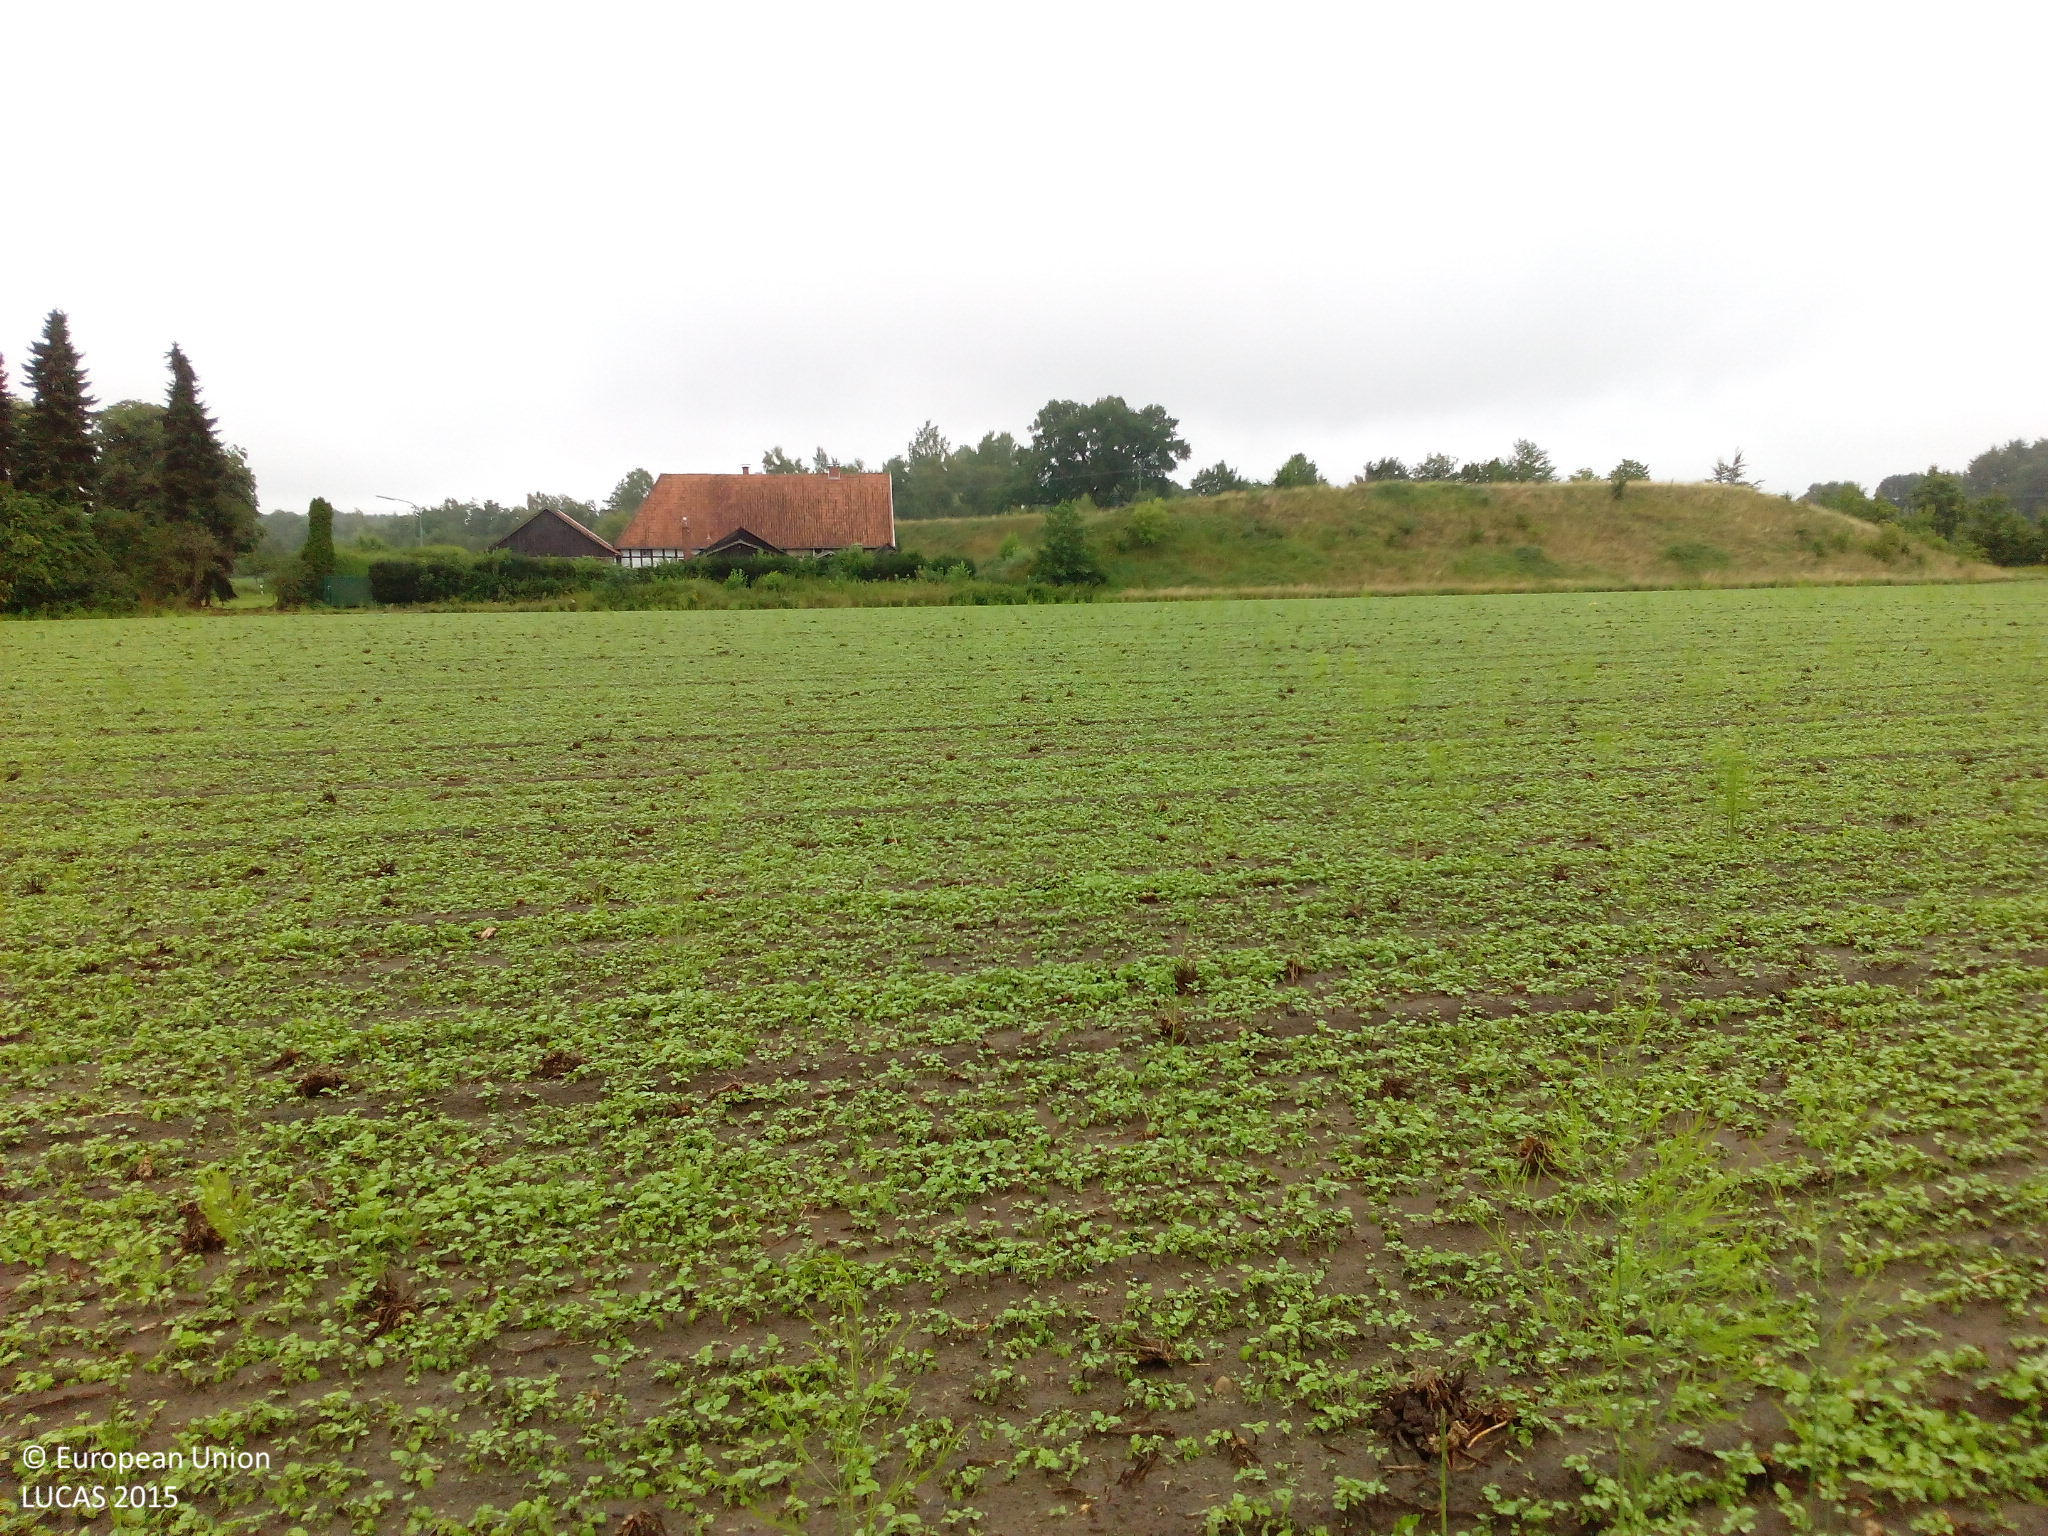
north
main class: Cropland
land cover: Other fresh vegetables
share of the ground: 10 - 25 %
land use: Agriculture (excluding fallow land and kitchen gardens)
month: August
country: DE
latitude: 52.0555
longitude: 8.0316
